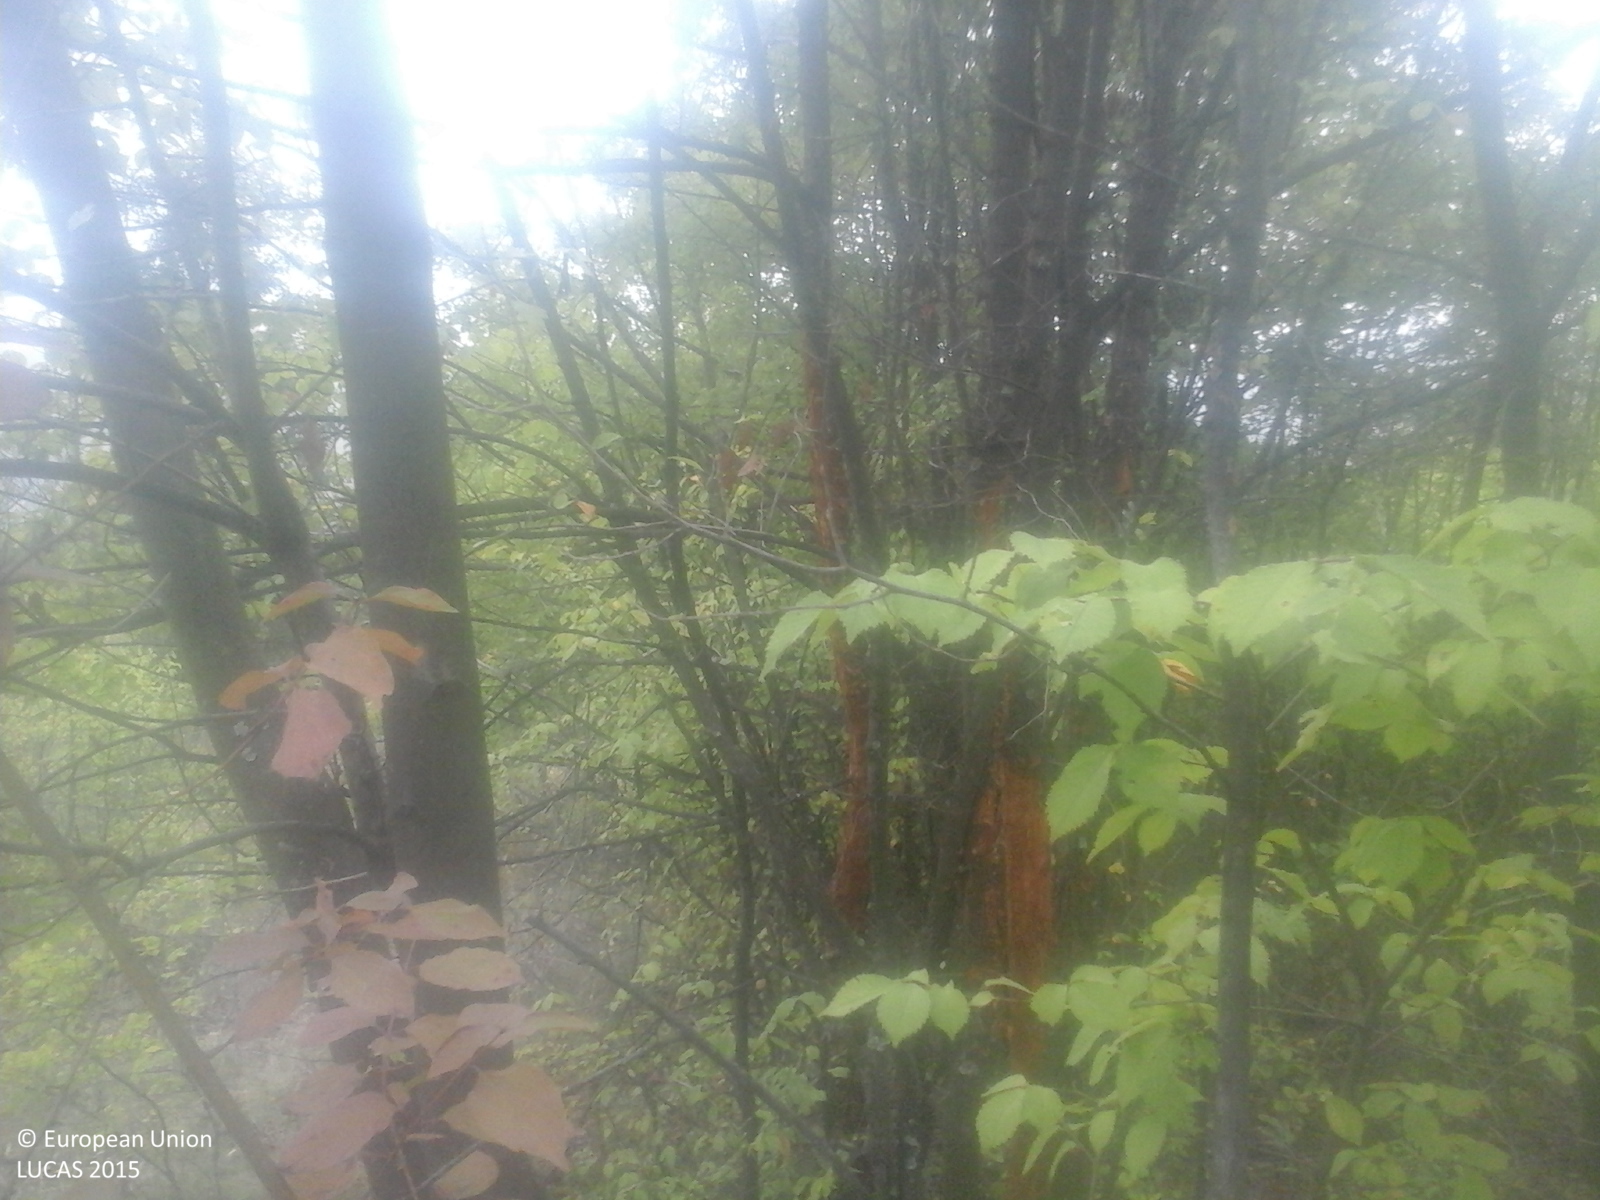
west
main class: Woodland
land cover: Broadleaved woodland
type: beech forest
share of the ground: > 75 %
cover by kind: broadleaved forest trees 100 %
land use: Forestry
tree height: > 5 m
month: September
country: RO
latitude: 44.8041
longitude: 23.1609
